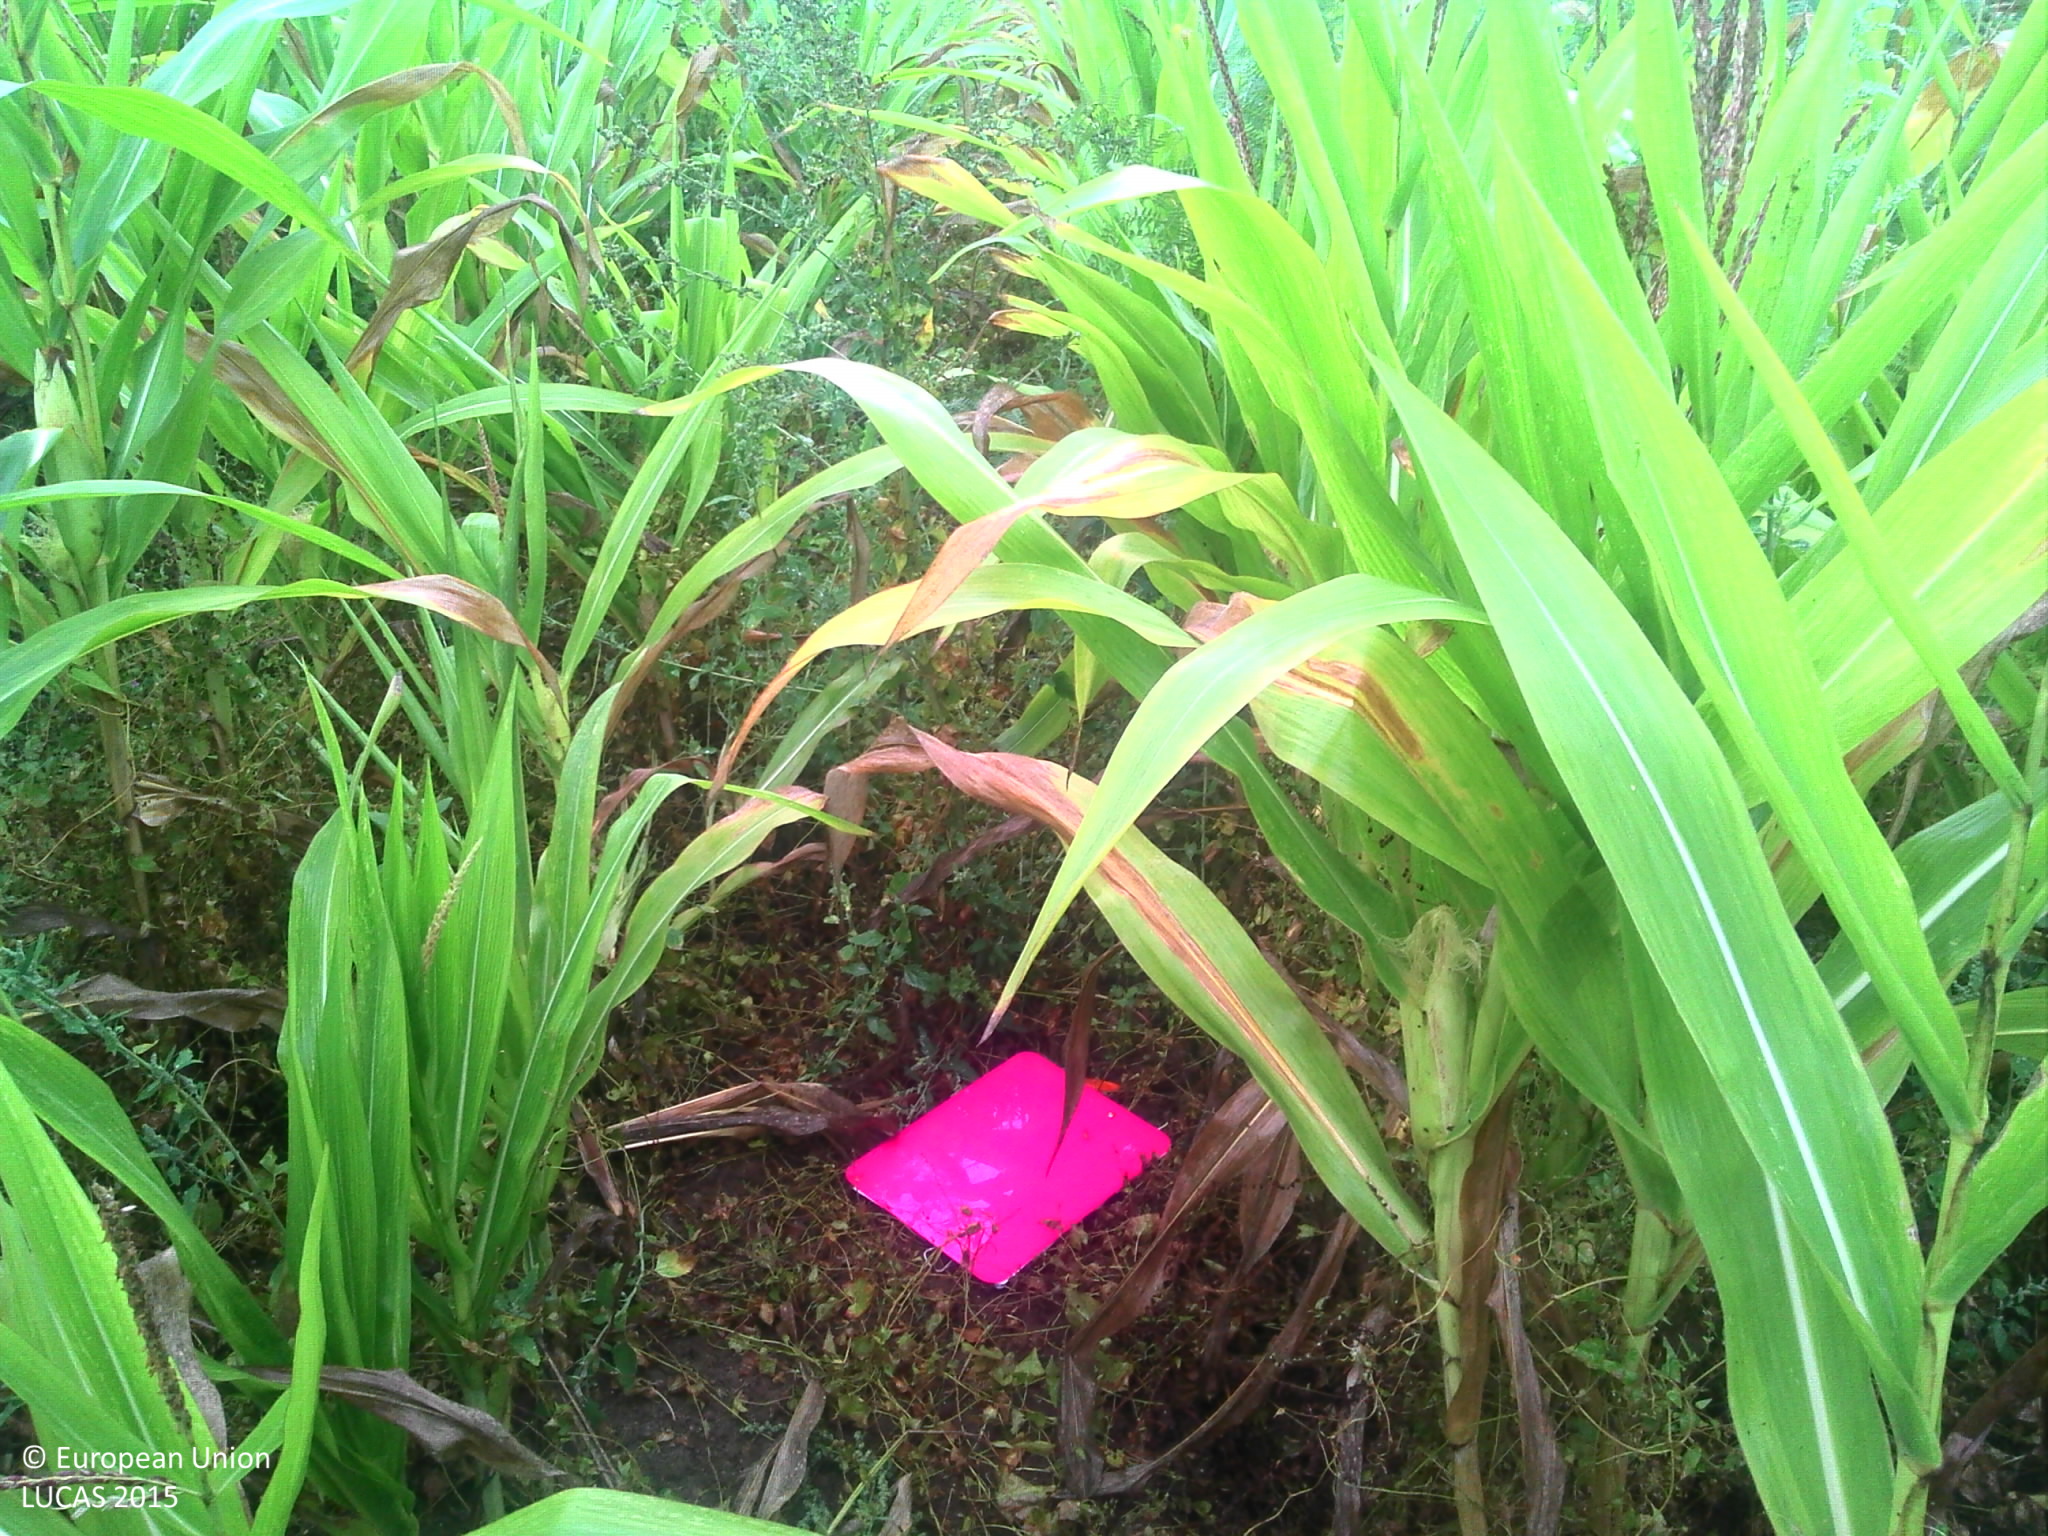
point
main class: Cropland
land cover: Maize
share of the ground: > 75 %
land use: Agriculture (excluding fallow land and kitchen gardens)
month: August
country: FR
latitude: 45.9662
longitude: 0.9420
